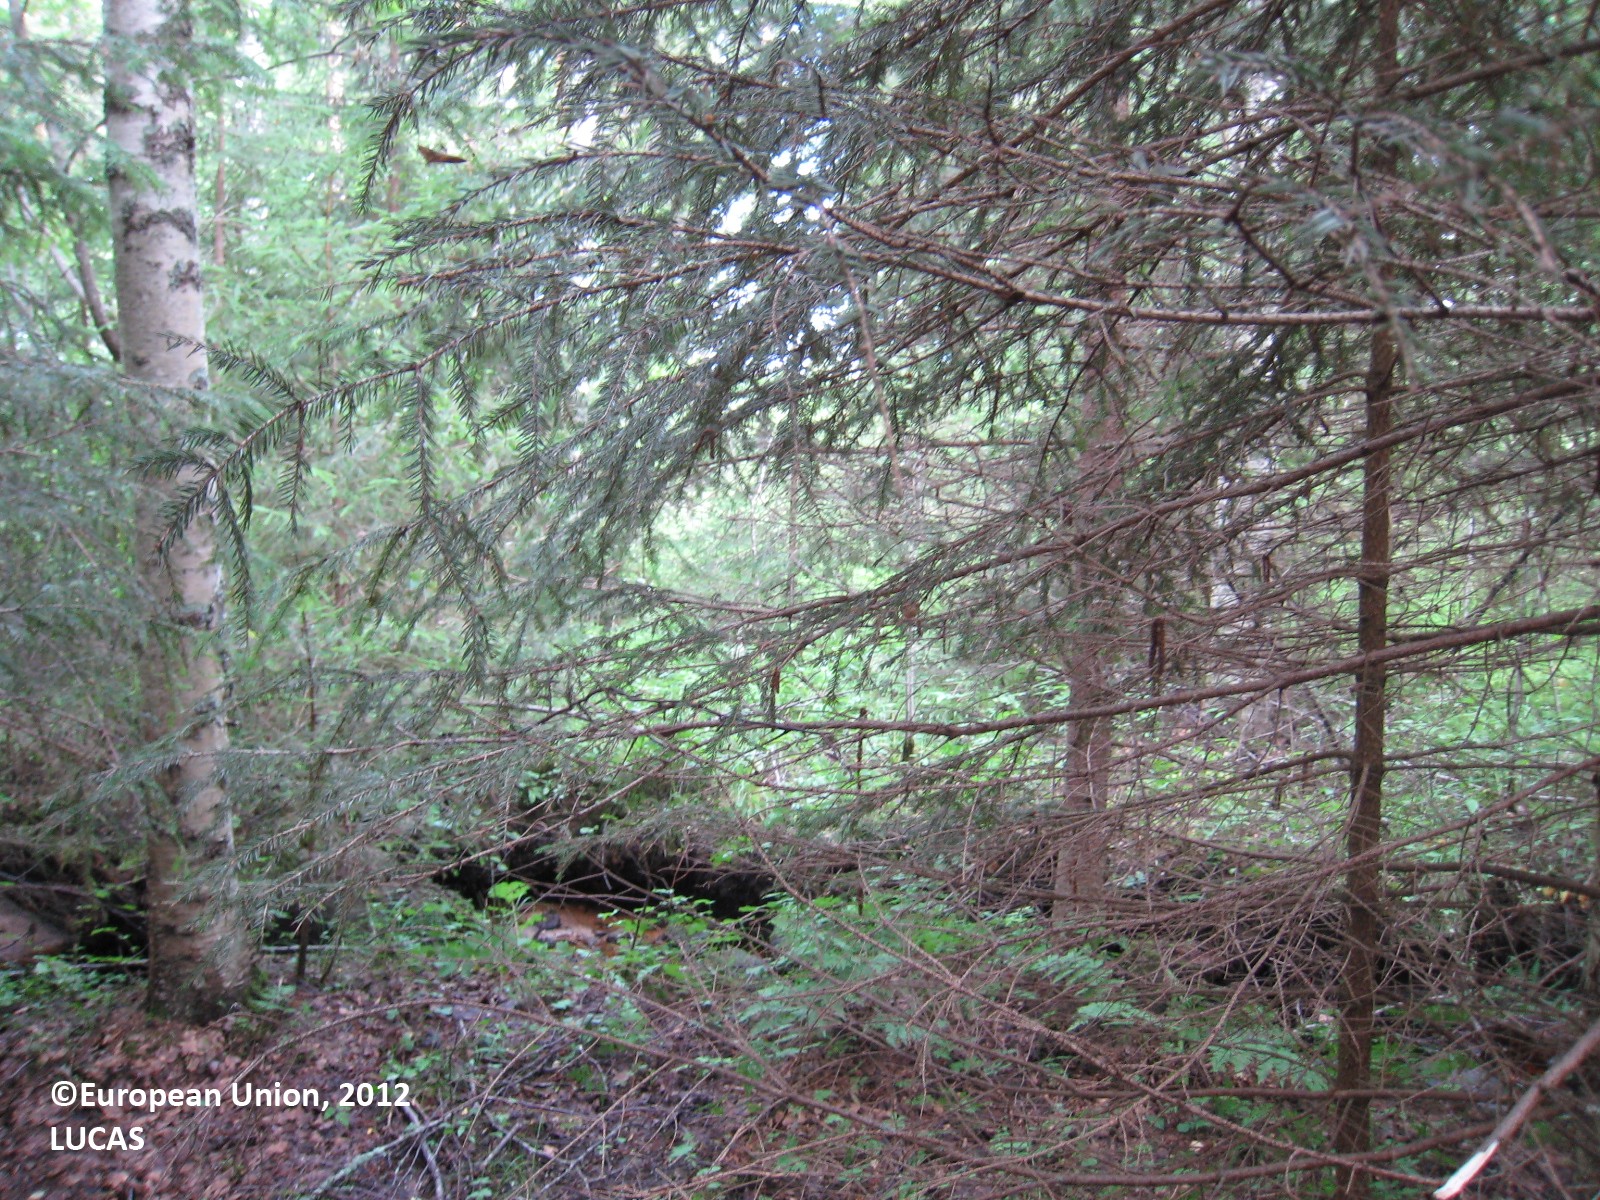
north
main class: Woodland
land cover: Spruce dominated mixed woodland
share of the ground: > 75 %
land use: Forestry
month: July
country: FI
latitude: 61.8981
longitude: 27.1177
